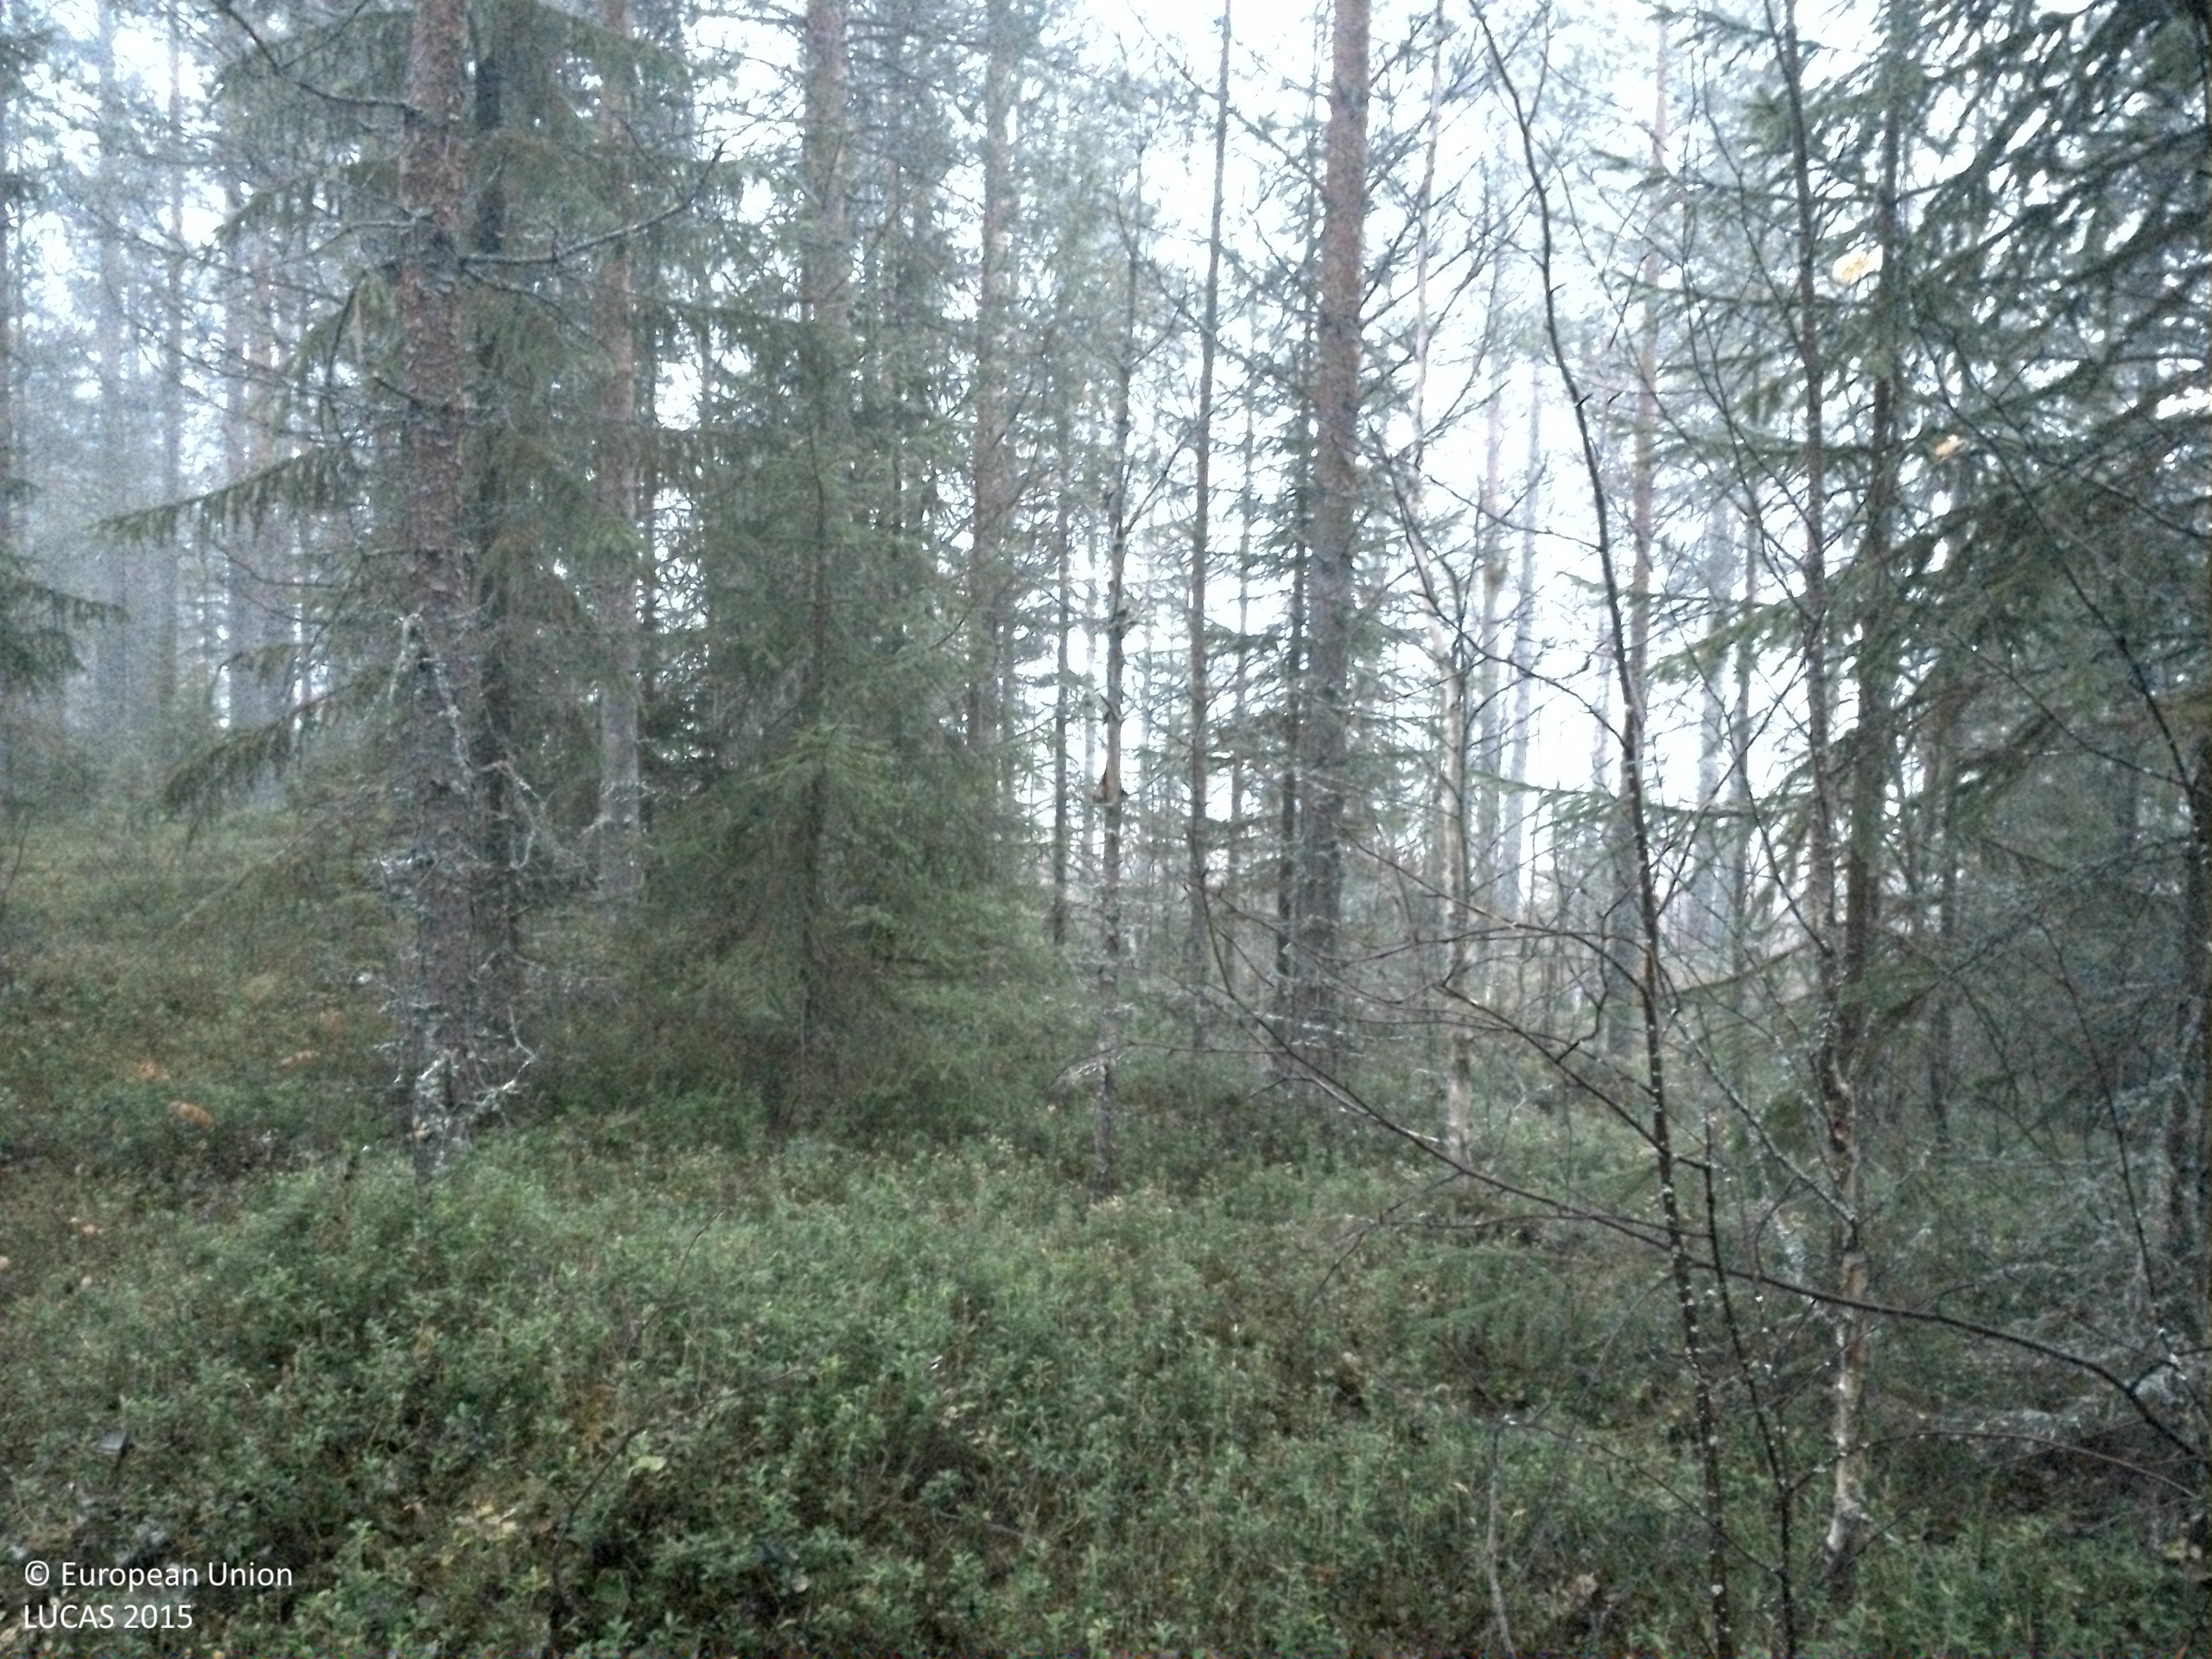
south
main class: Woodland
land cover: Pine dominated mixed woodland
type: boreal forest
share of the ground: 50 - 75 %
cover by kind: coniferous forest trees 45 %, shrubs 30 %, broadleaved forest trees 15 %, lichens and mosses 10 %
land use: Forestry
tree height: > 5 m
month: October
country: SE
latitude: 64.0915
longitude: 16.3091
